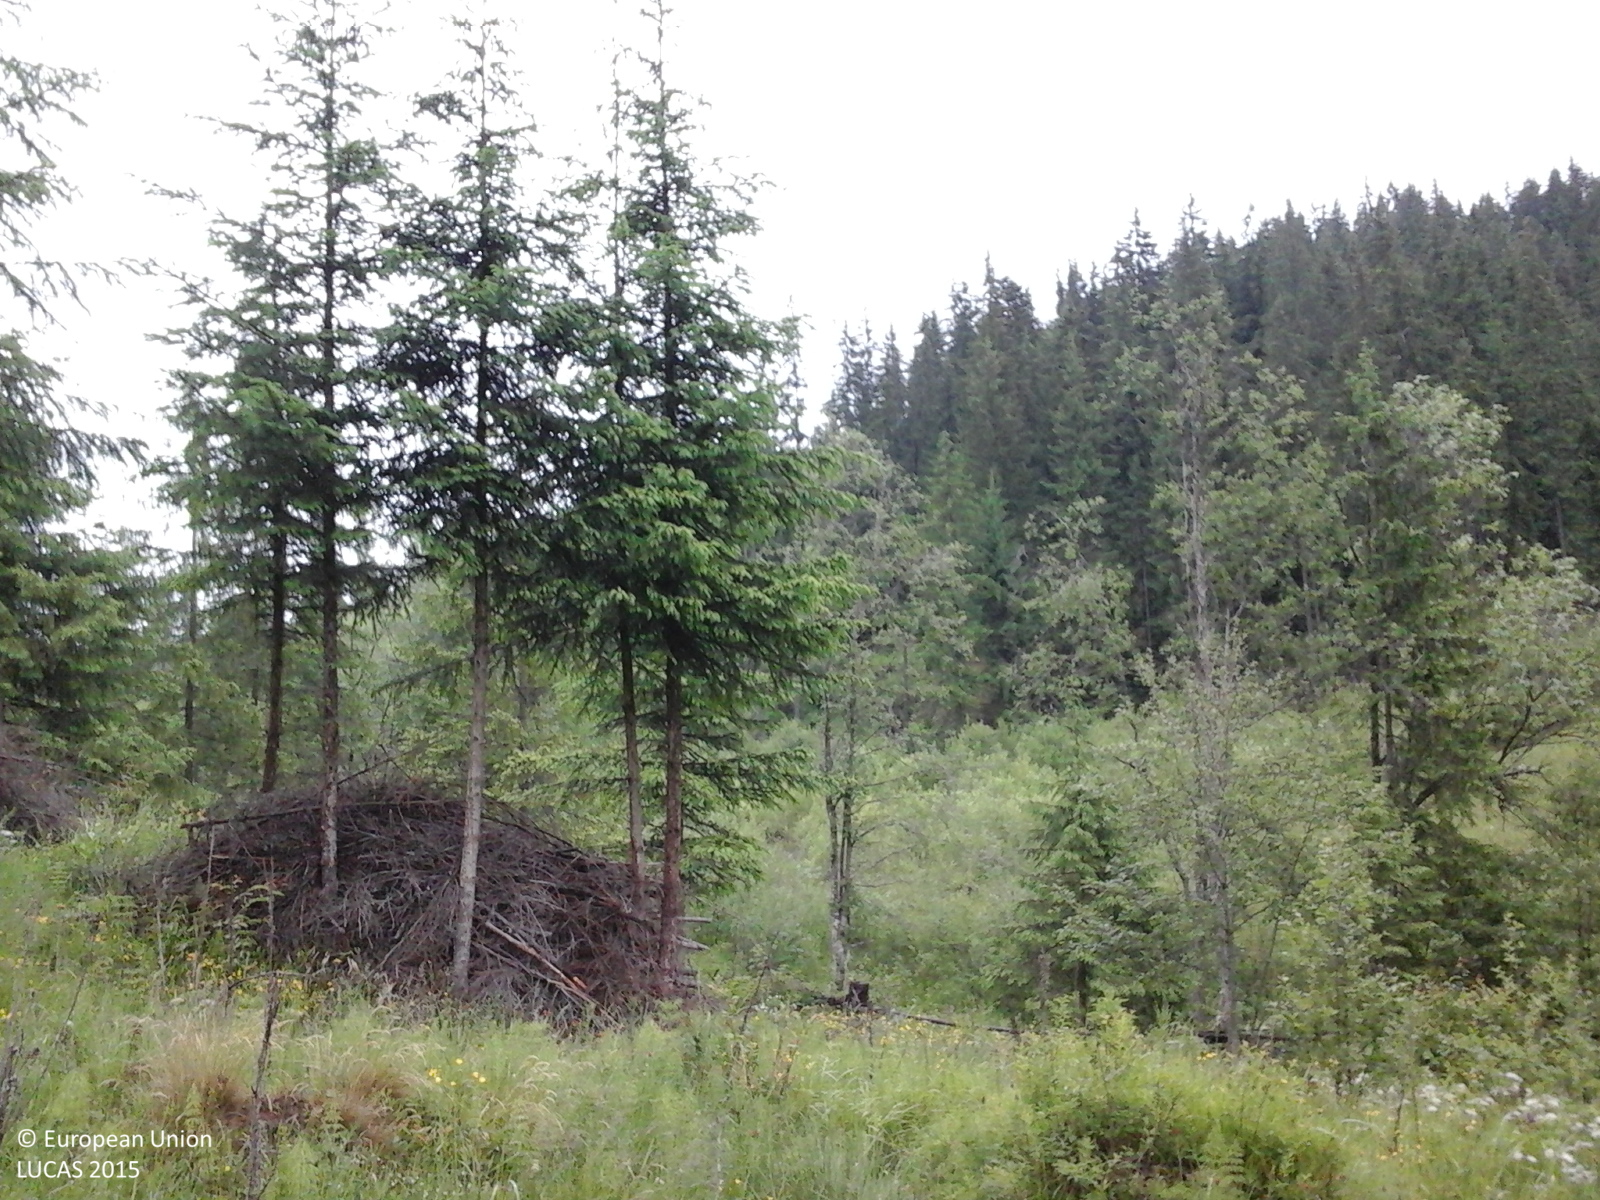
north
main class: Grassland
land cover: Grassland with sparse tree/shrub cover
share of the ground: > 75 %
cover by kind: herbaceous plants 85 %, shrubs 10 %, coniferous forest trees 5 %
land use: Agriculture (excluding fallow land and kitchen gardens)
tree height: > 5 m
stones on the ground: < 10 %
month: June
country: RO
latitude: 47.6029
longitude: 25.3156
